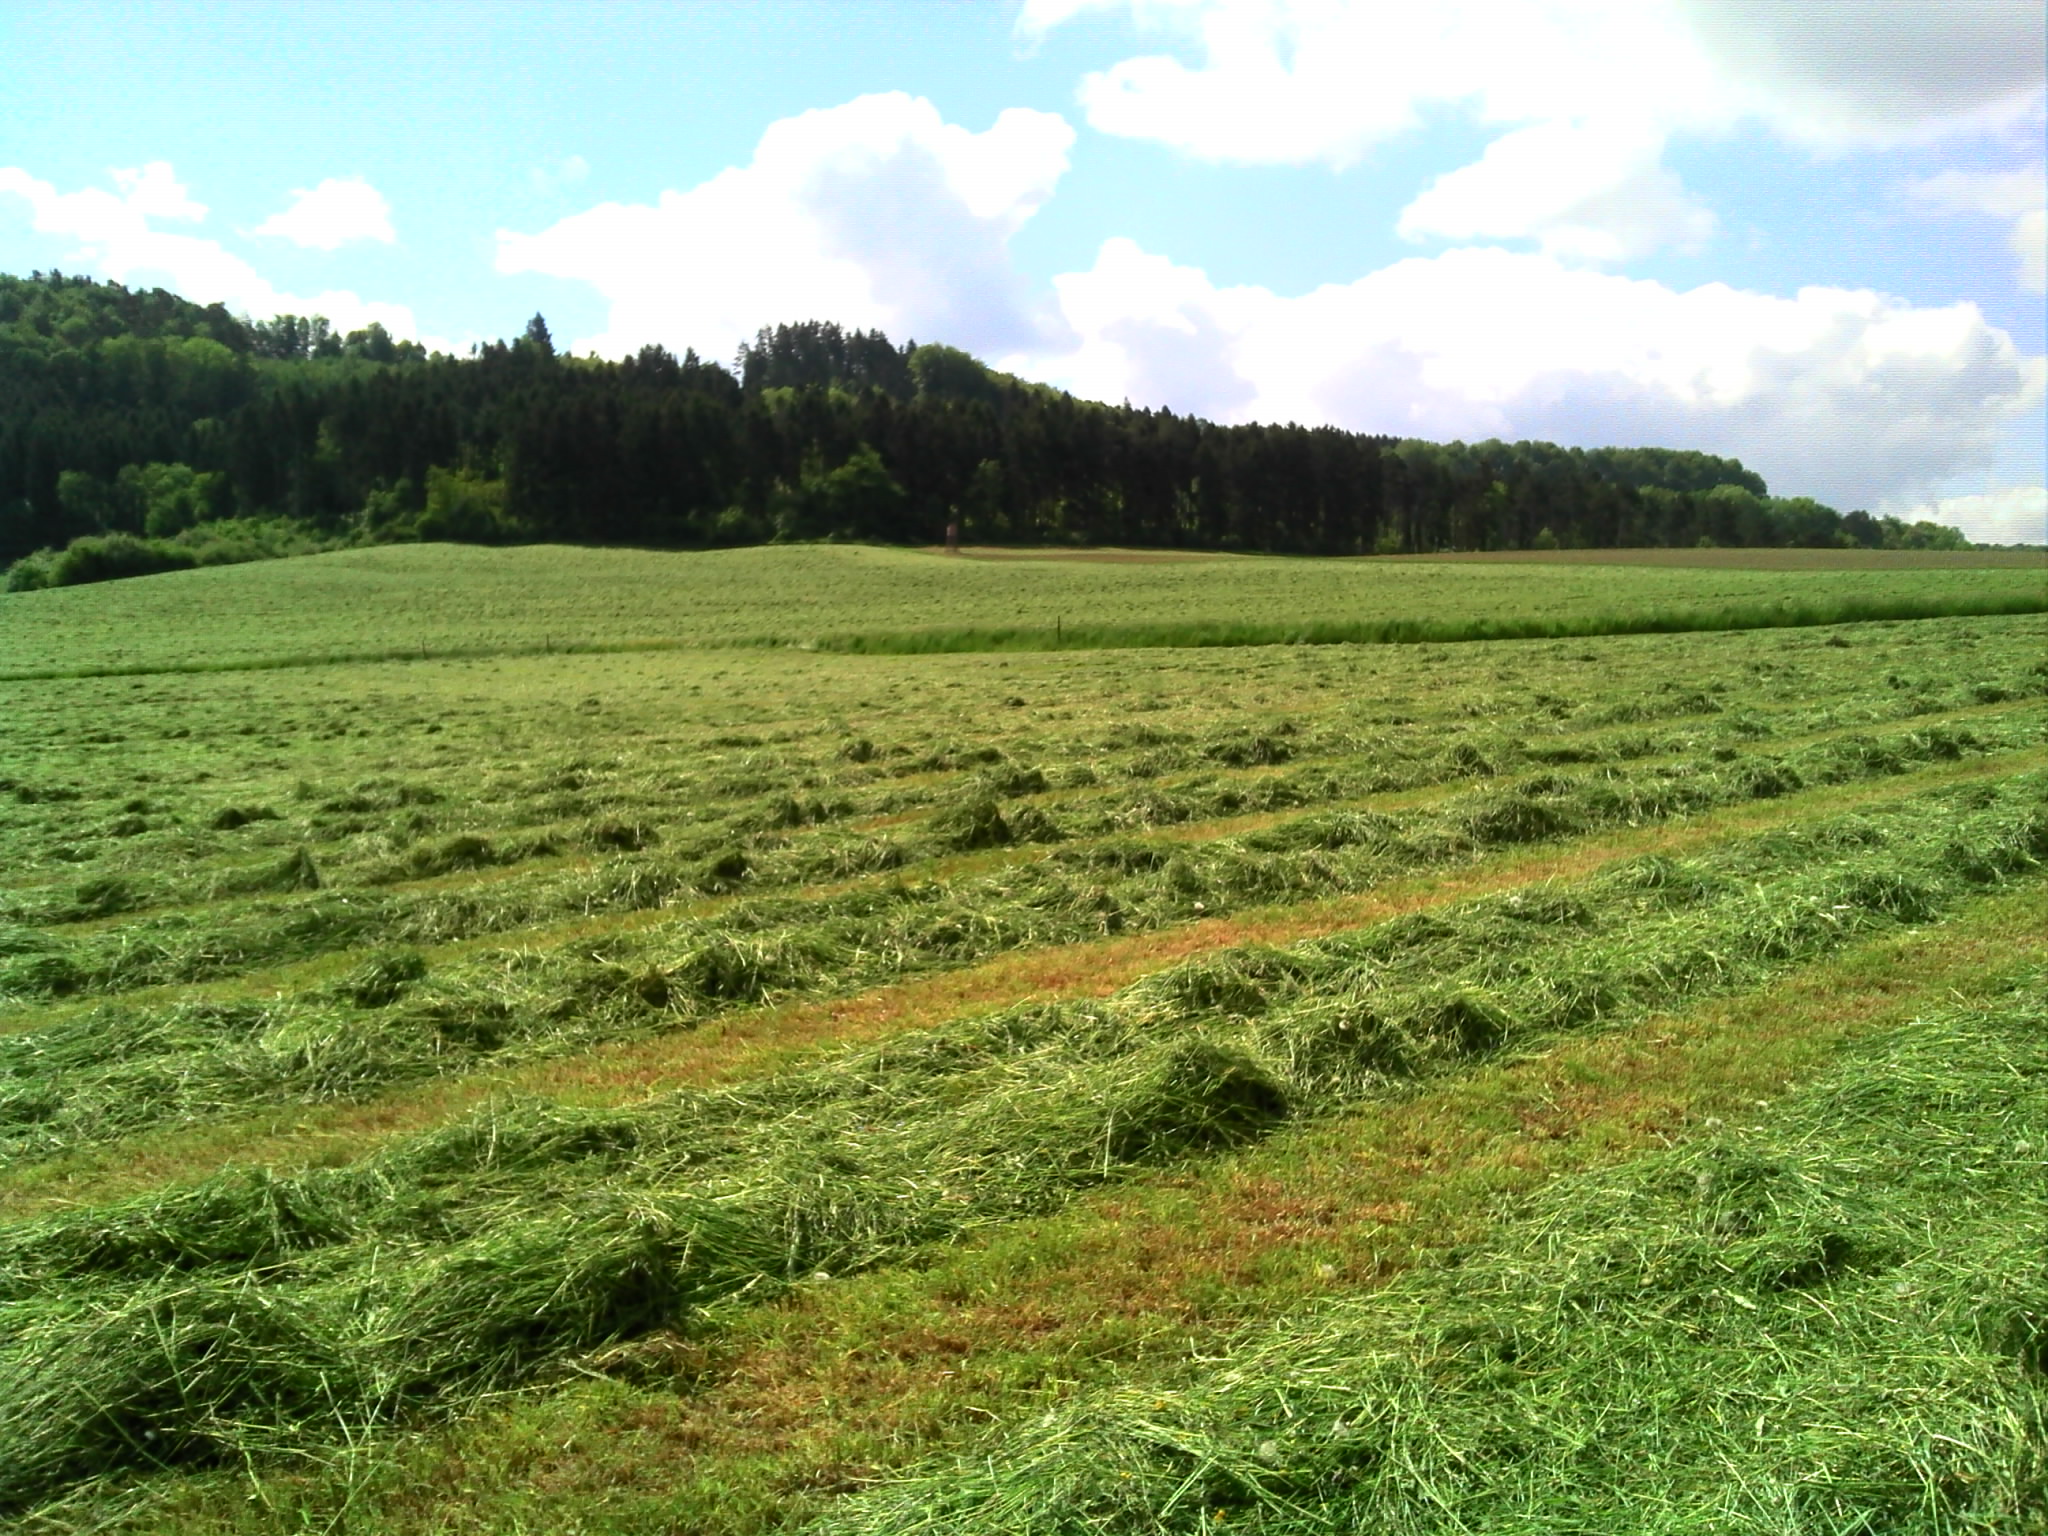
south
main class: Grassland
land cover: Grassland without tree/shrub cover
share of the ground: > 75 %
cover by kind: herbaceous plants 100 %
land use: Agriculture (excluding fallow land and kitchen gardens)
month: May
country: LU
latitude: 49.8528
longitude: 6.2581
